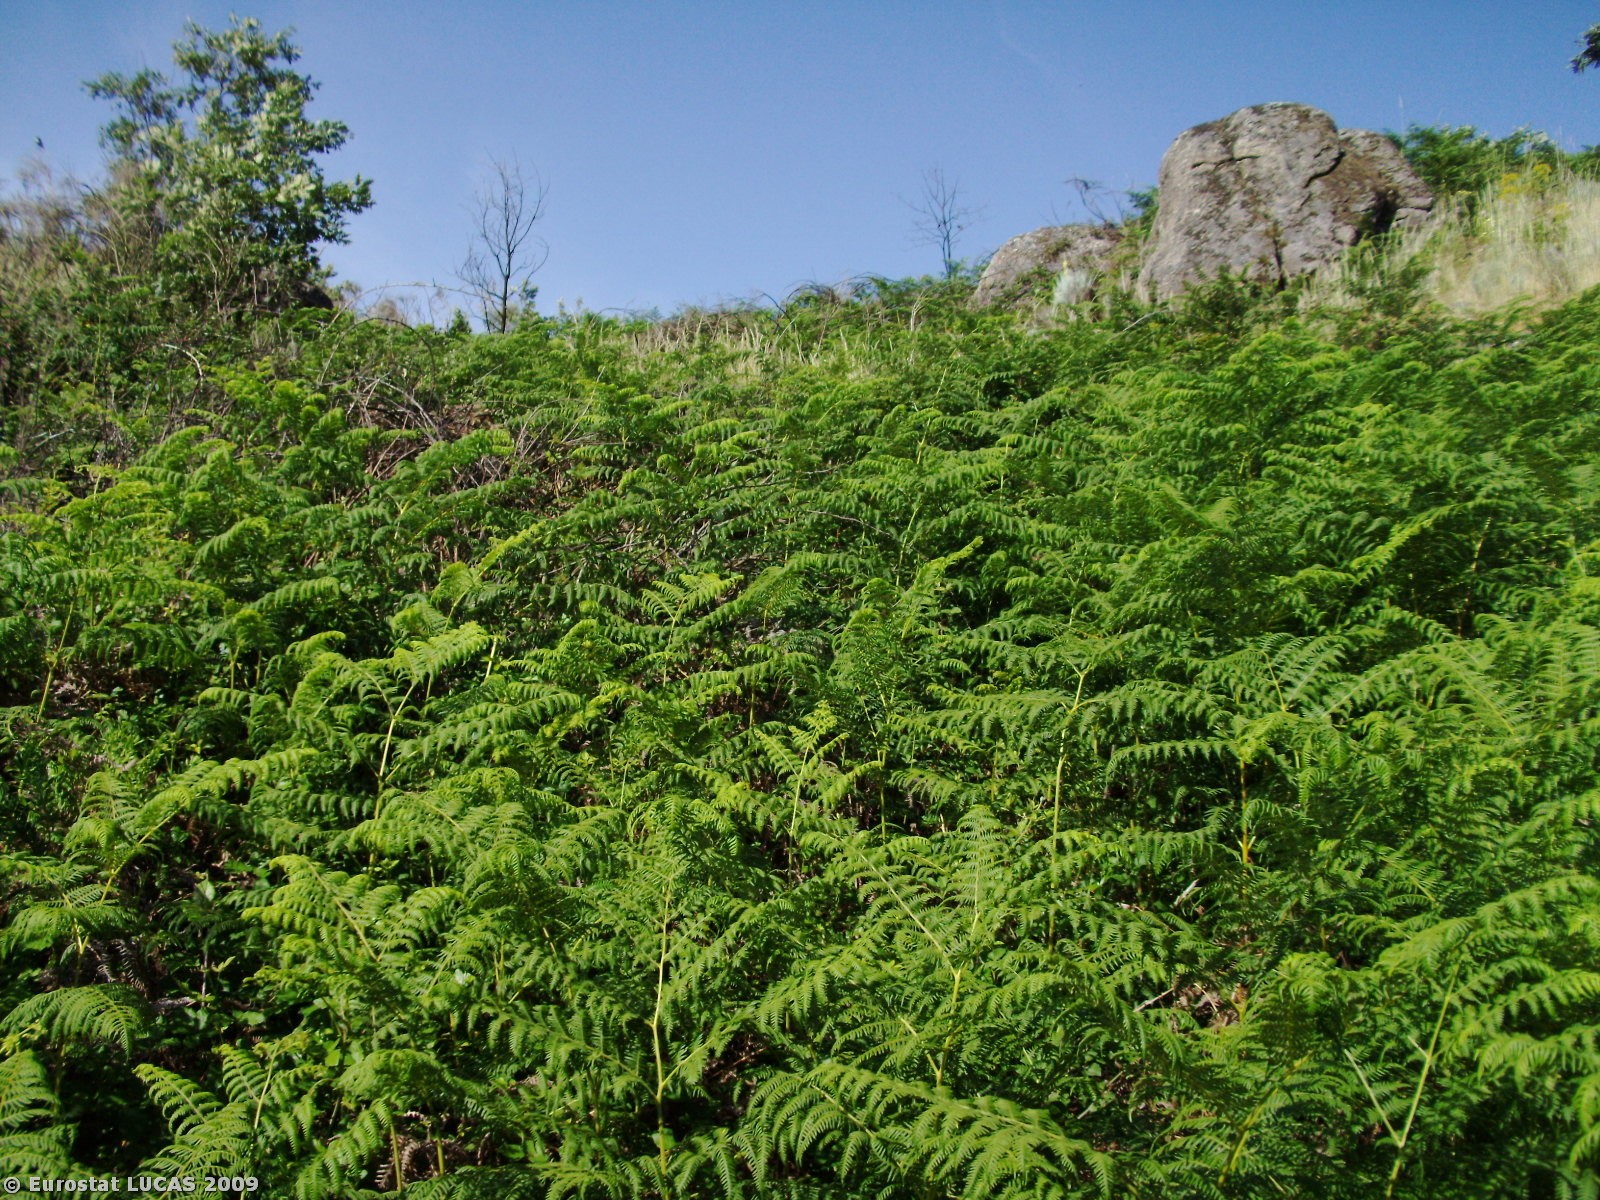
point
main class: Shrubland
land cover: Shrubland with sparse tree cover
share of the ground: > 75 %
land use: Fallow land
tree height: > 5 m
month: June
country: PT
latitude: 40.6090
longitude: -7.4499
